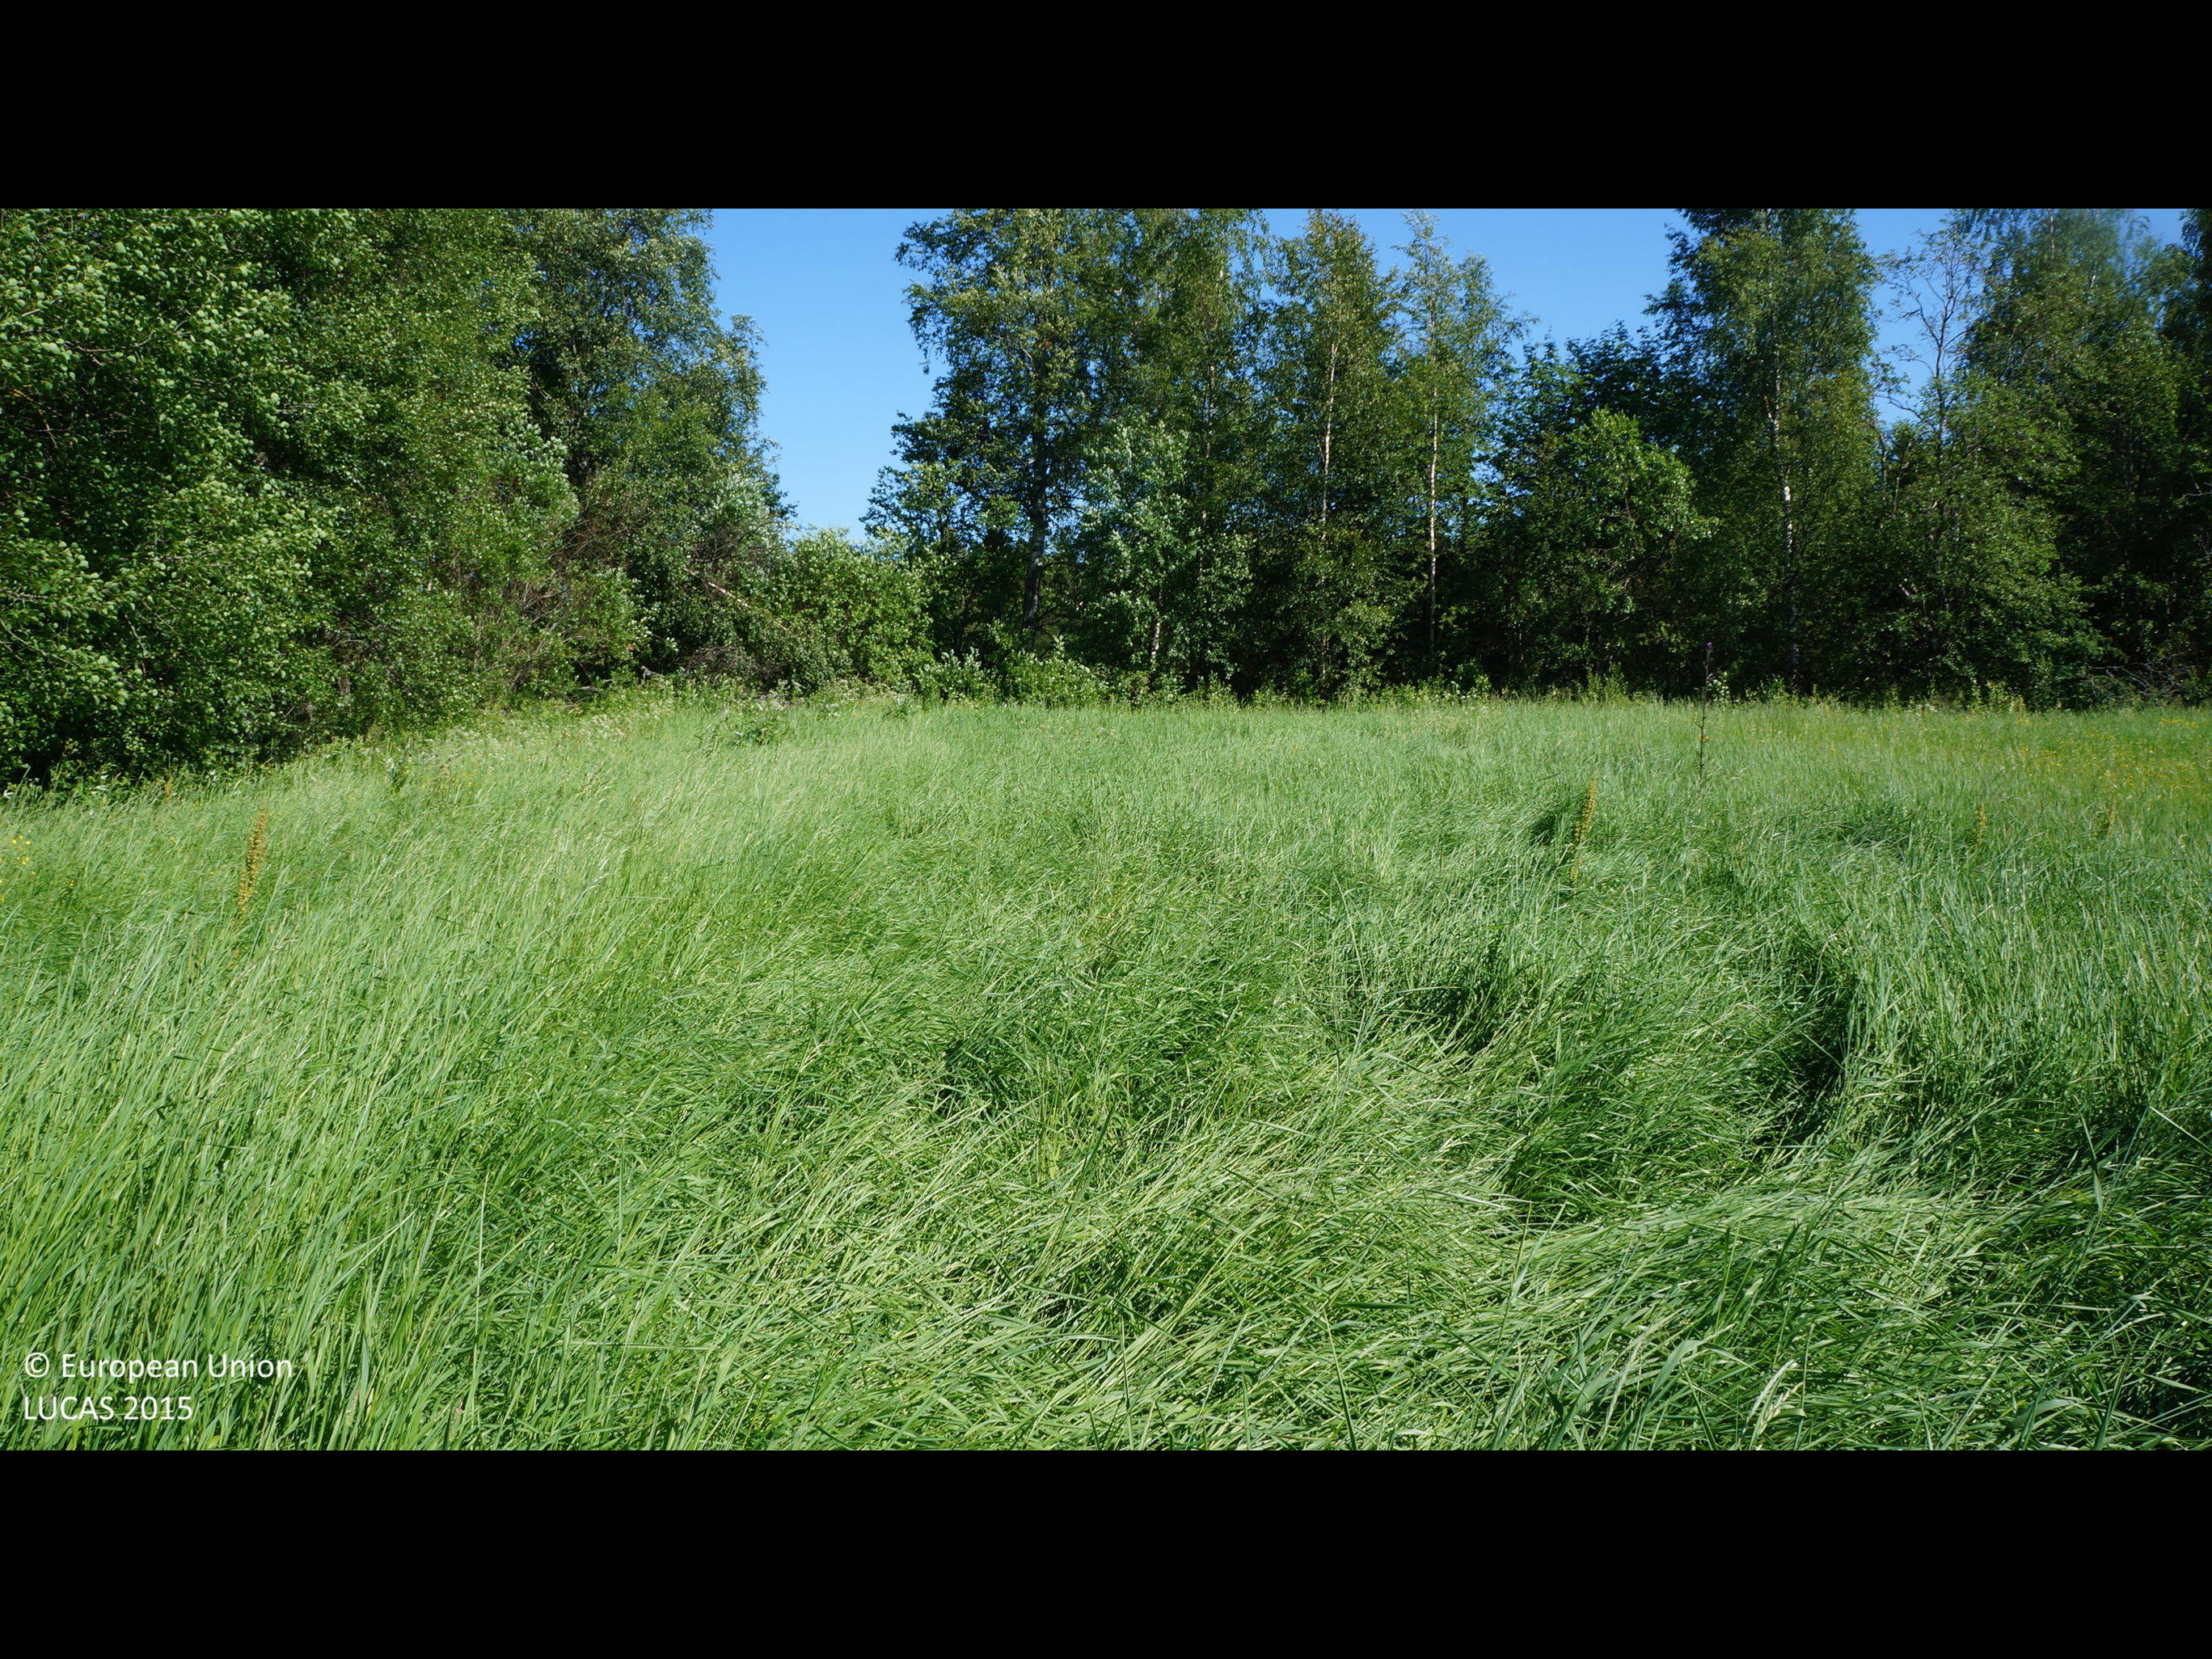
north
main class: Cropland
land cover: Temporary grasslands
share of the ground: > 75 %
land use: Agriculture (excluding fallow land and kitchen gardens)
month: July
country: FI
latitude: 63.8102
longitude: 22.9463
